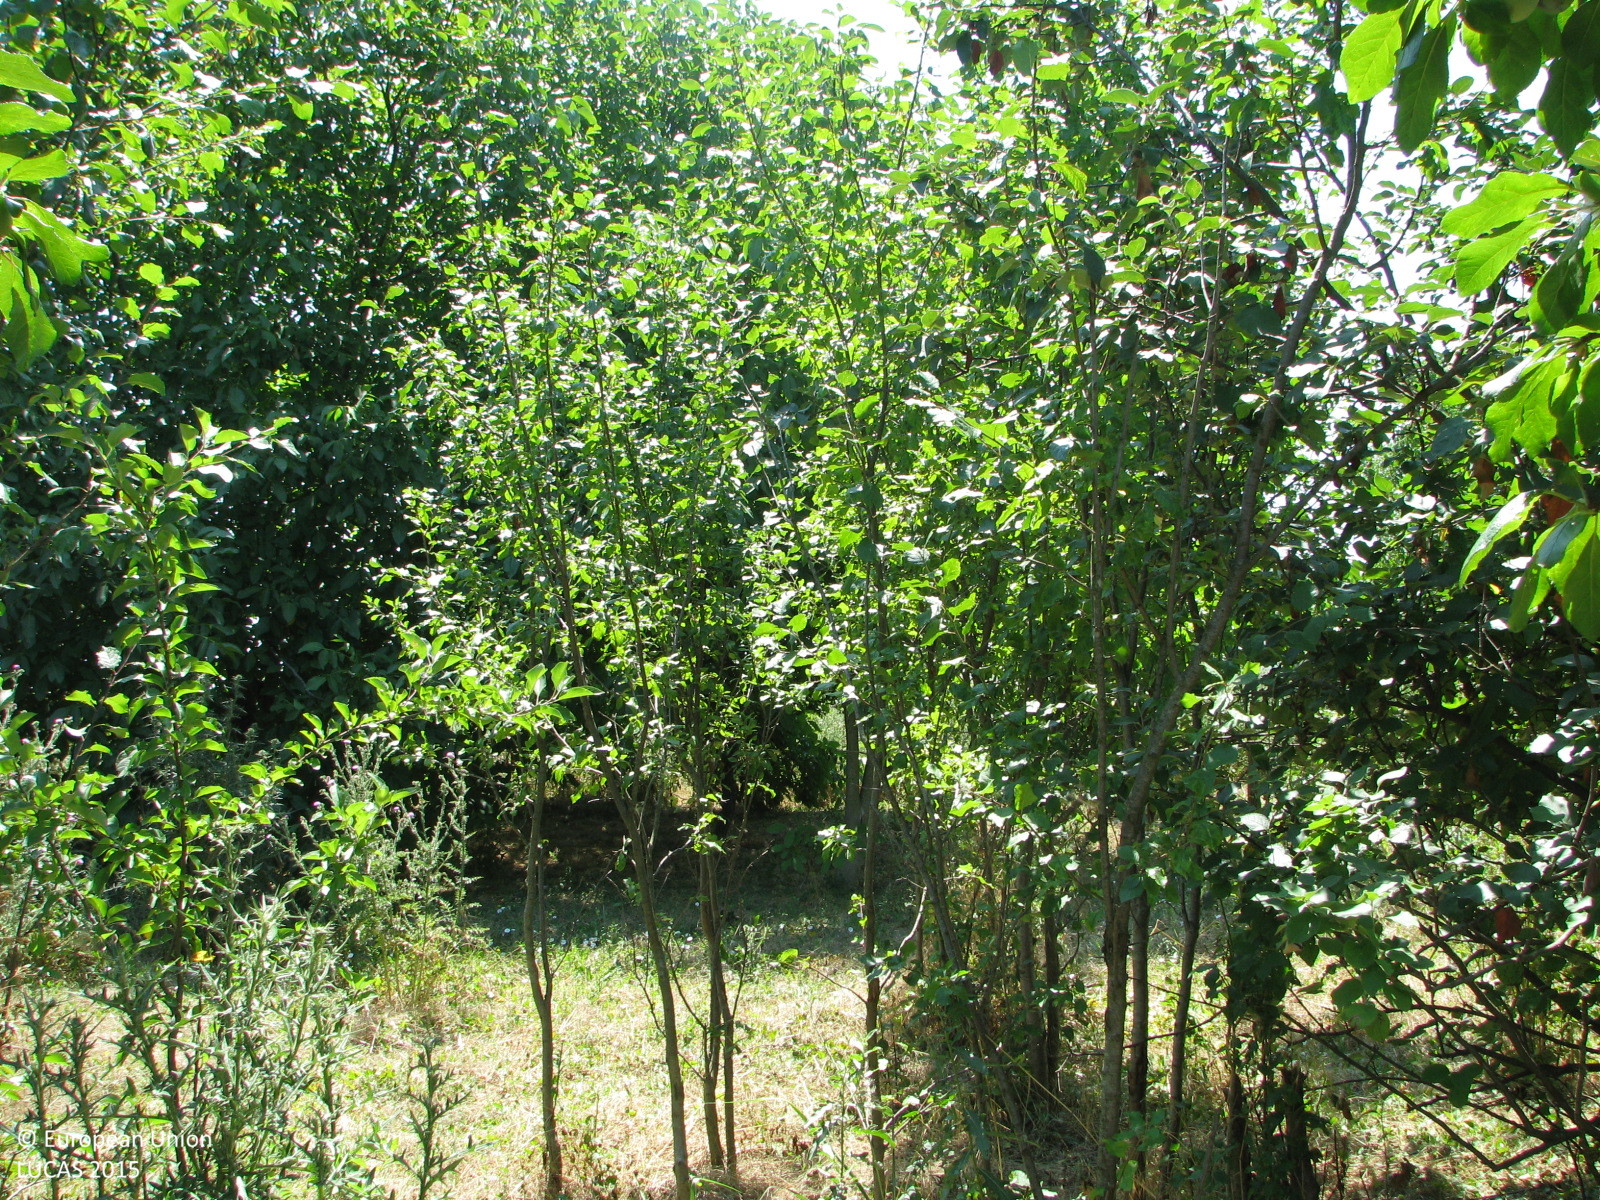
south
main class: Cropland
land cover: Other fruit trees and berries
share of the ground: 50 - 75 %
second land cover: Spontaneously vegetated surfaces
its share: 25 - 50 %
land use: Abandoned areas
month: July
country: BG
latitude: 42.4672
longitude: 26.4986
